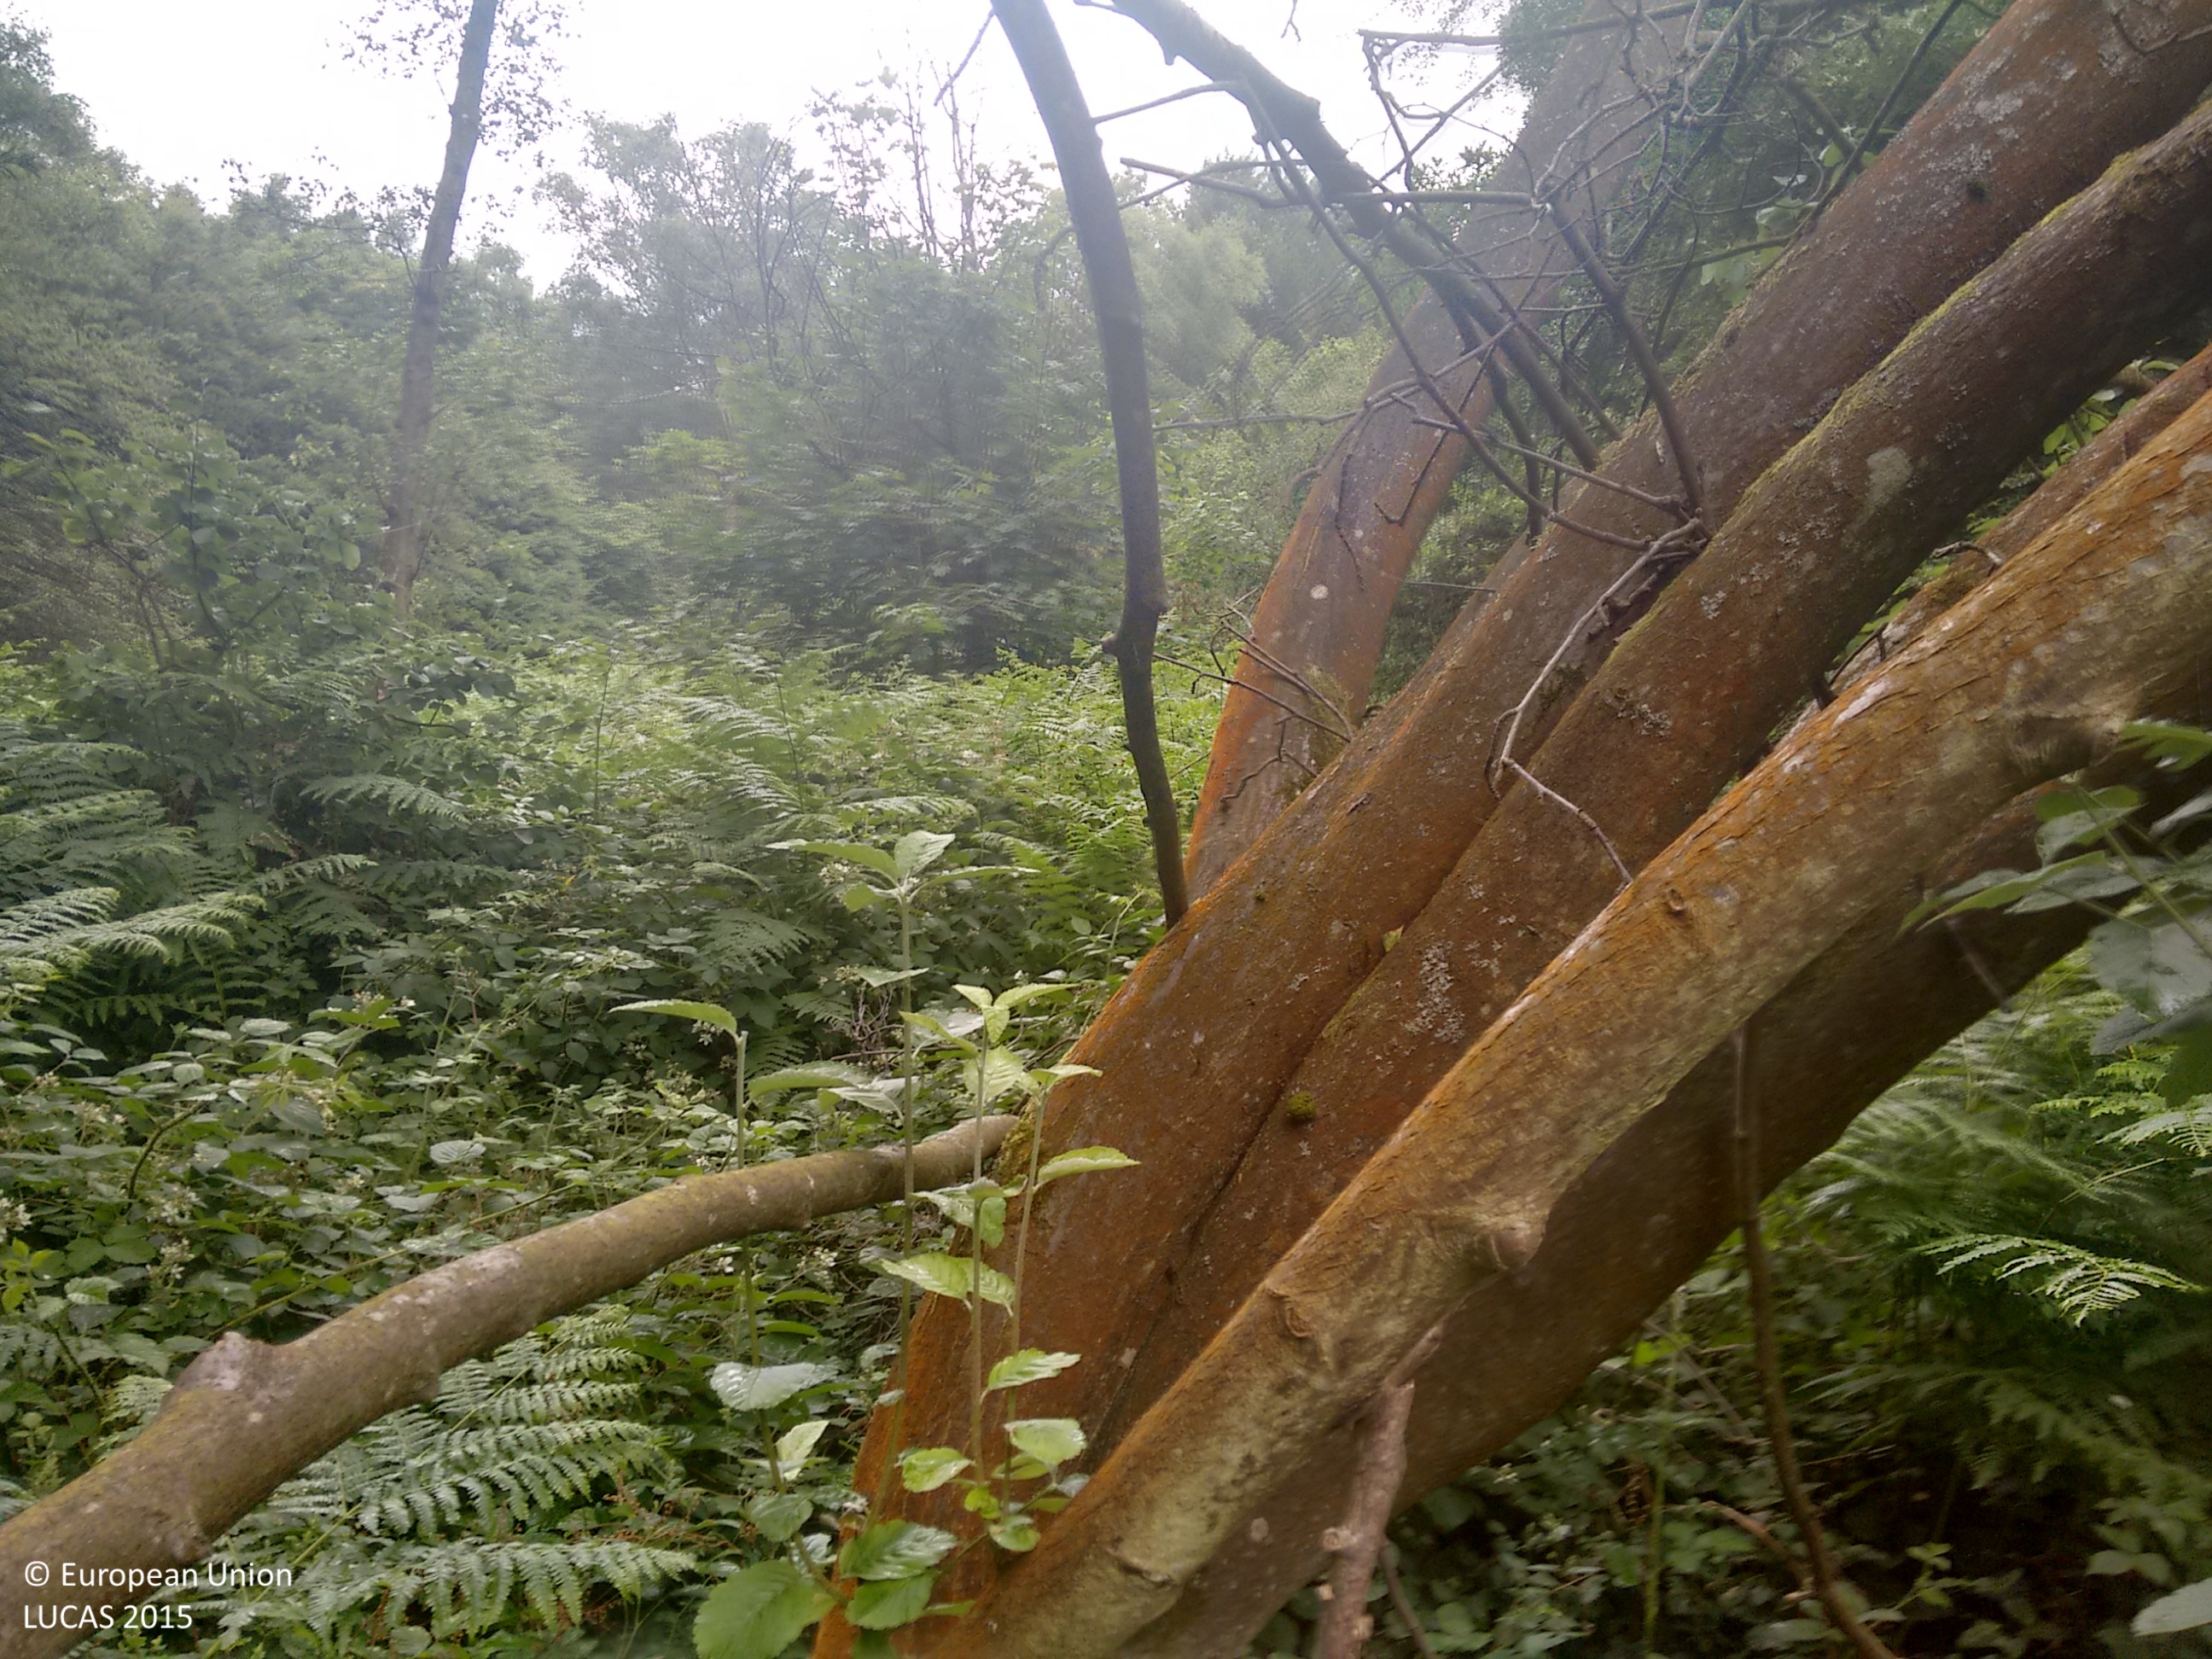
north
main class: Woodland
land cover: Other mixed woodland
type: mesophytic deciduous forest
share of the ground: > 75 %
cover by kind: broadleaved forest trees 60 %, coniferous forest trees 40 %
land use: Forestry
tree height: > 5 m
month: July
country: GB
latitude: 51.2387
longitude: -0.5090
